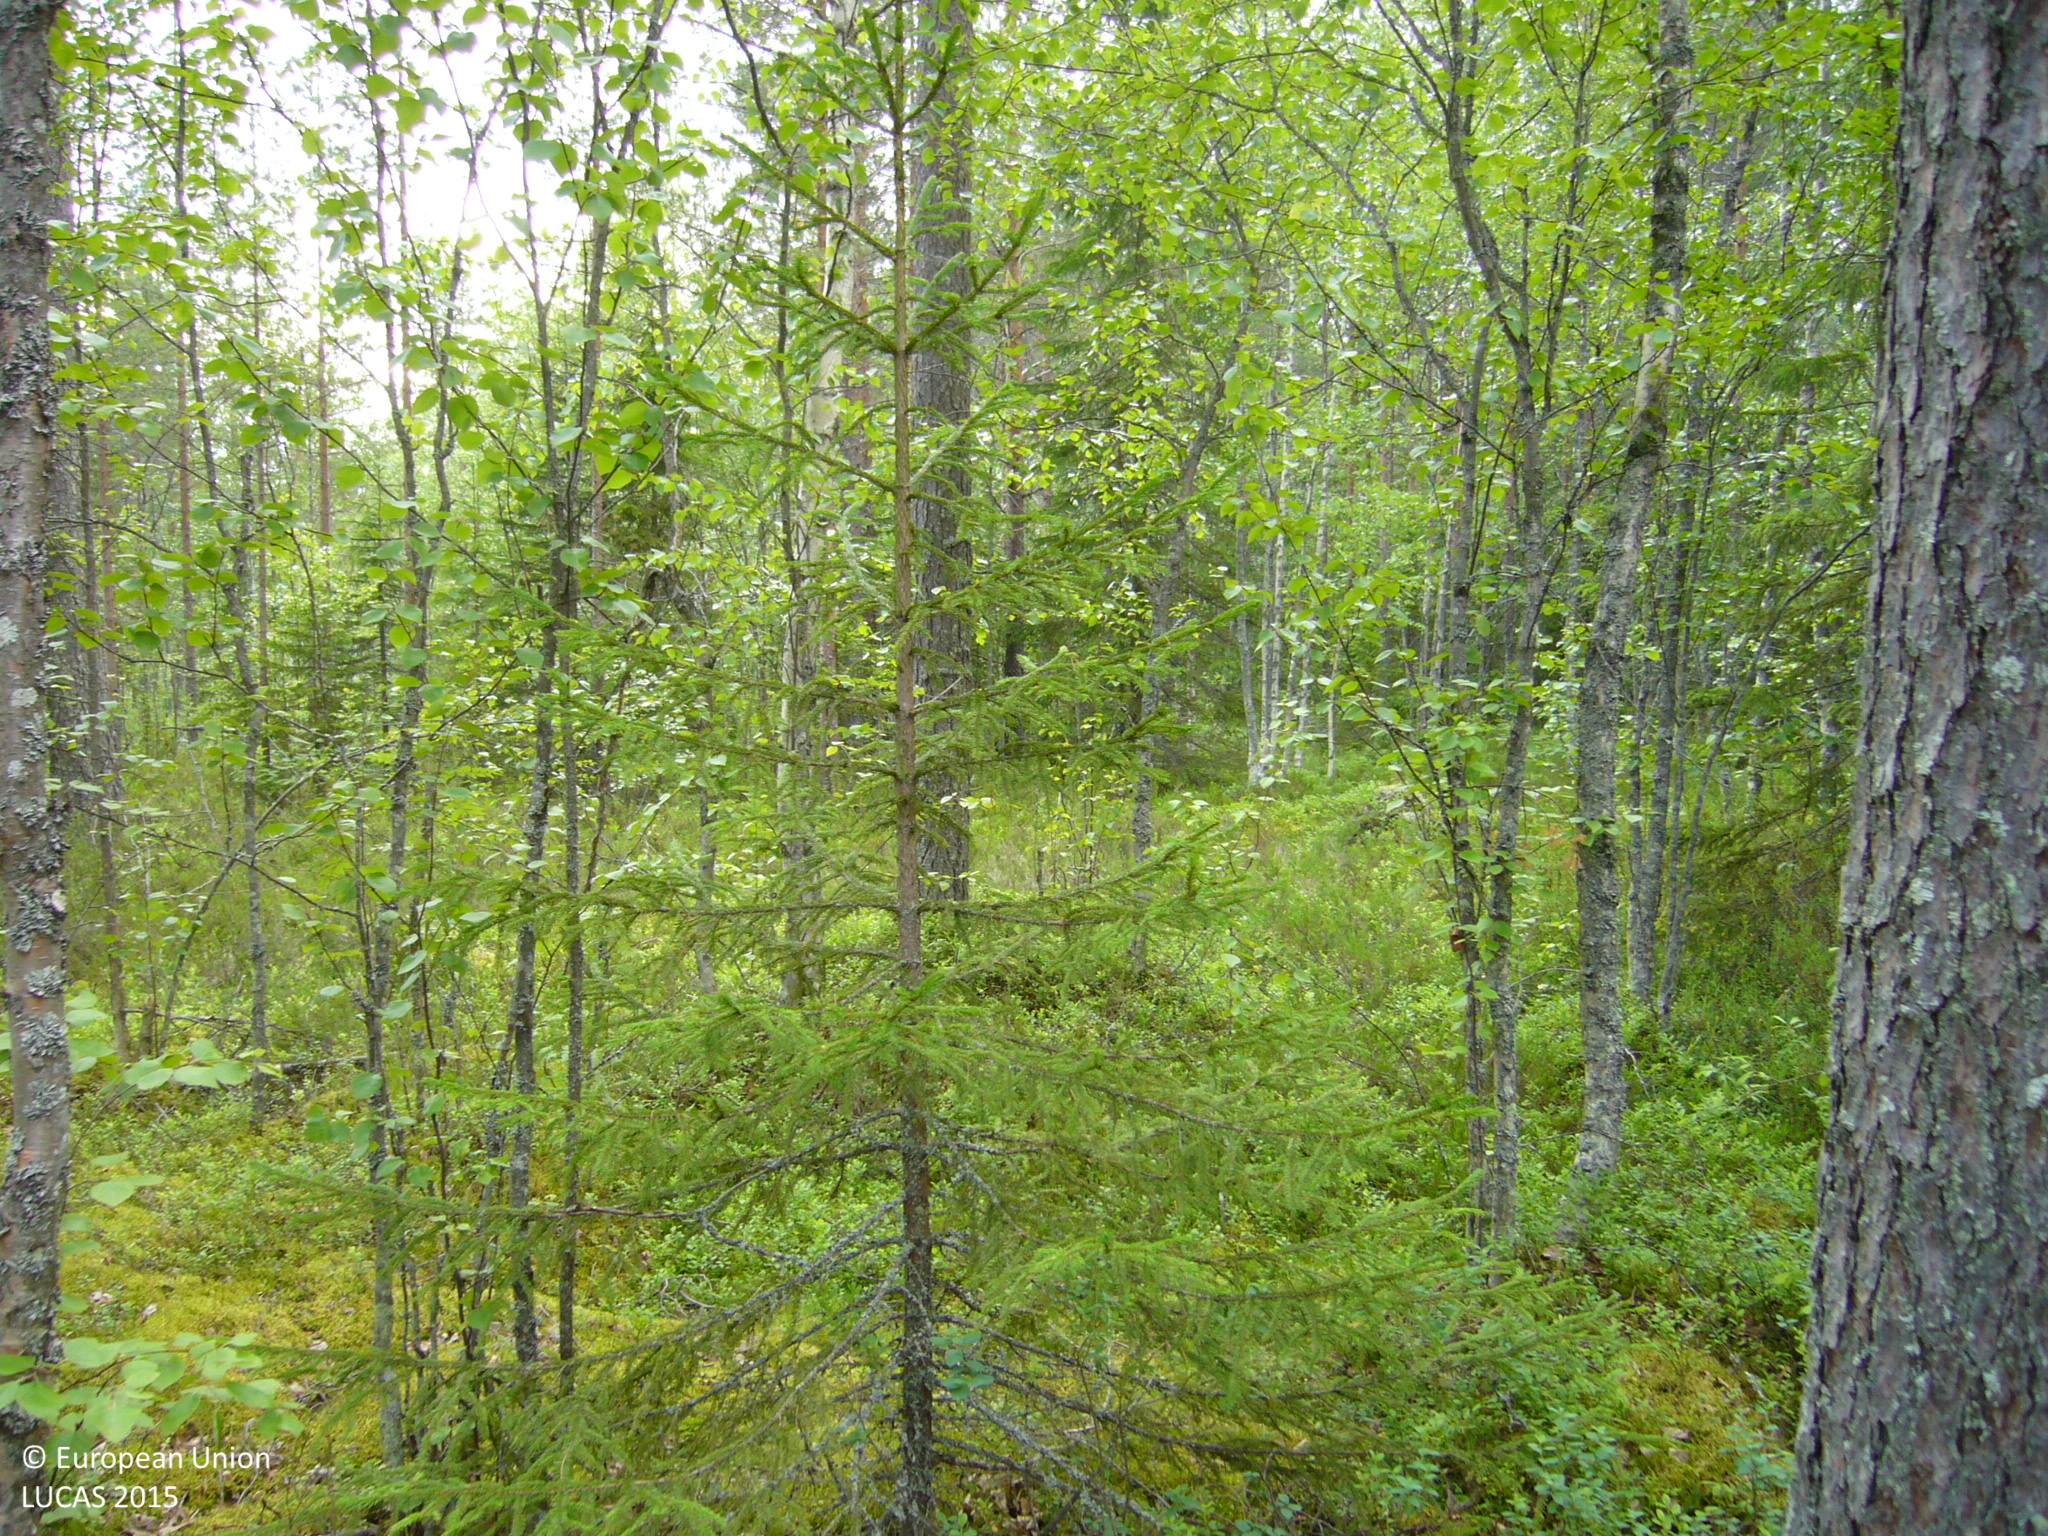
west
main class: Woodland
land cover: Pine dominated mixed woodland
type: boreal forest
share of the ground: 50 - 75 %
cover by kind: coniferous forest trees 40 %, shrubs 35 %, broadleaved forest trees 25 %
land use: Forestry
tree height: > 5 m
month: July
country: FI
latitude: 63.6976
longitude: 25.7409
